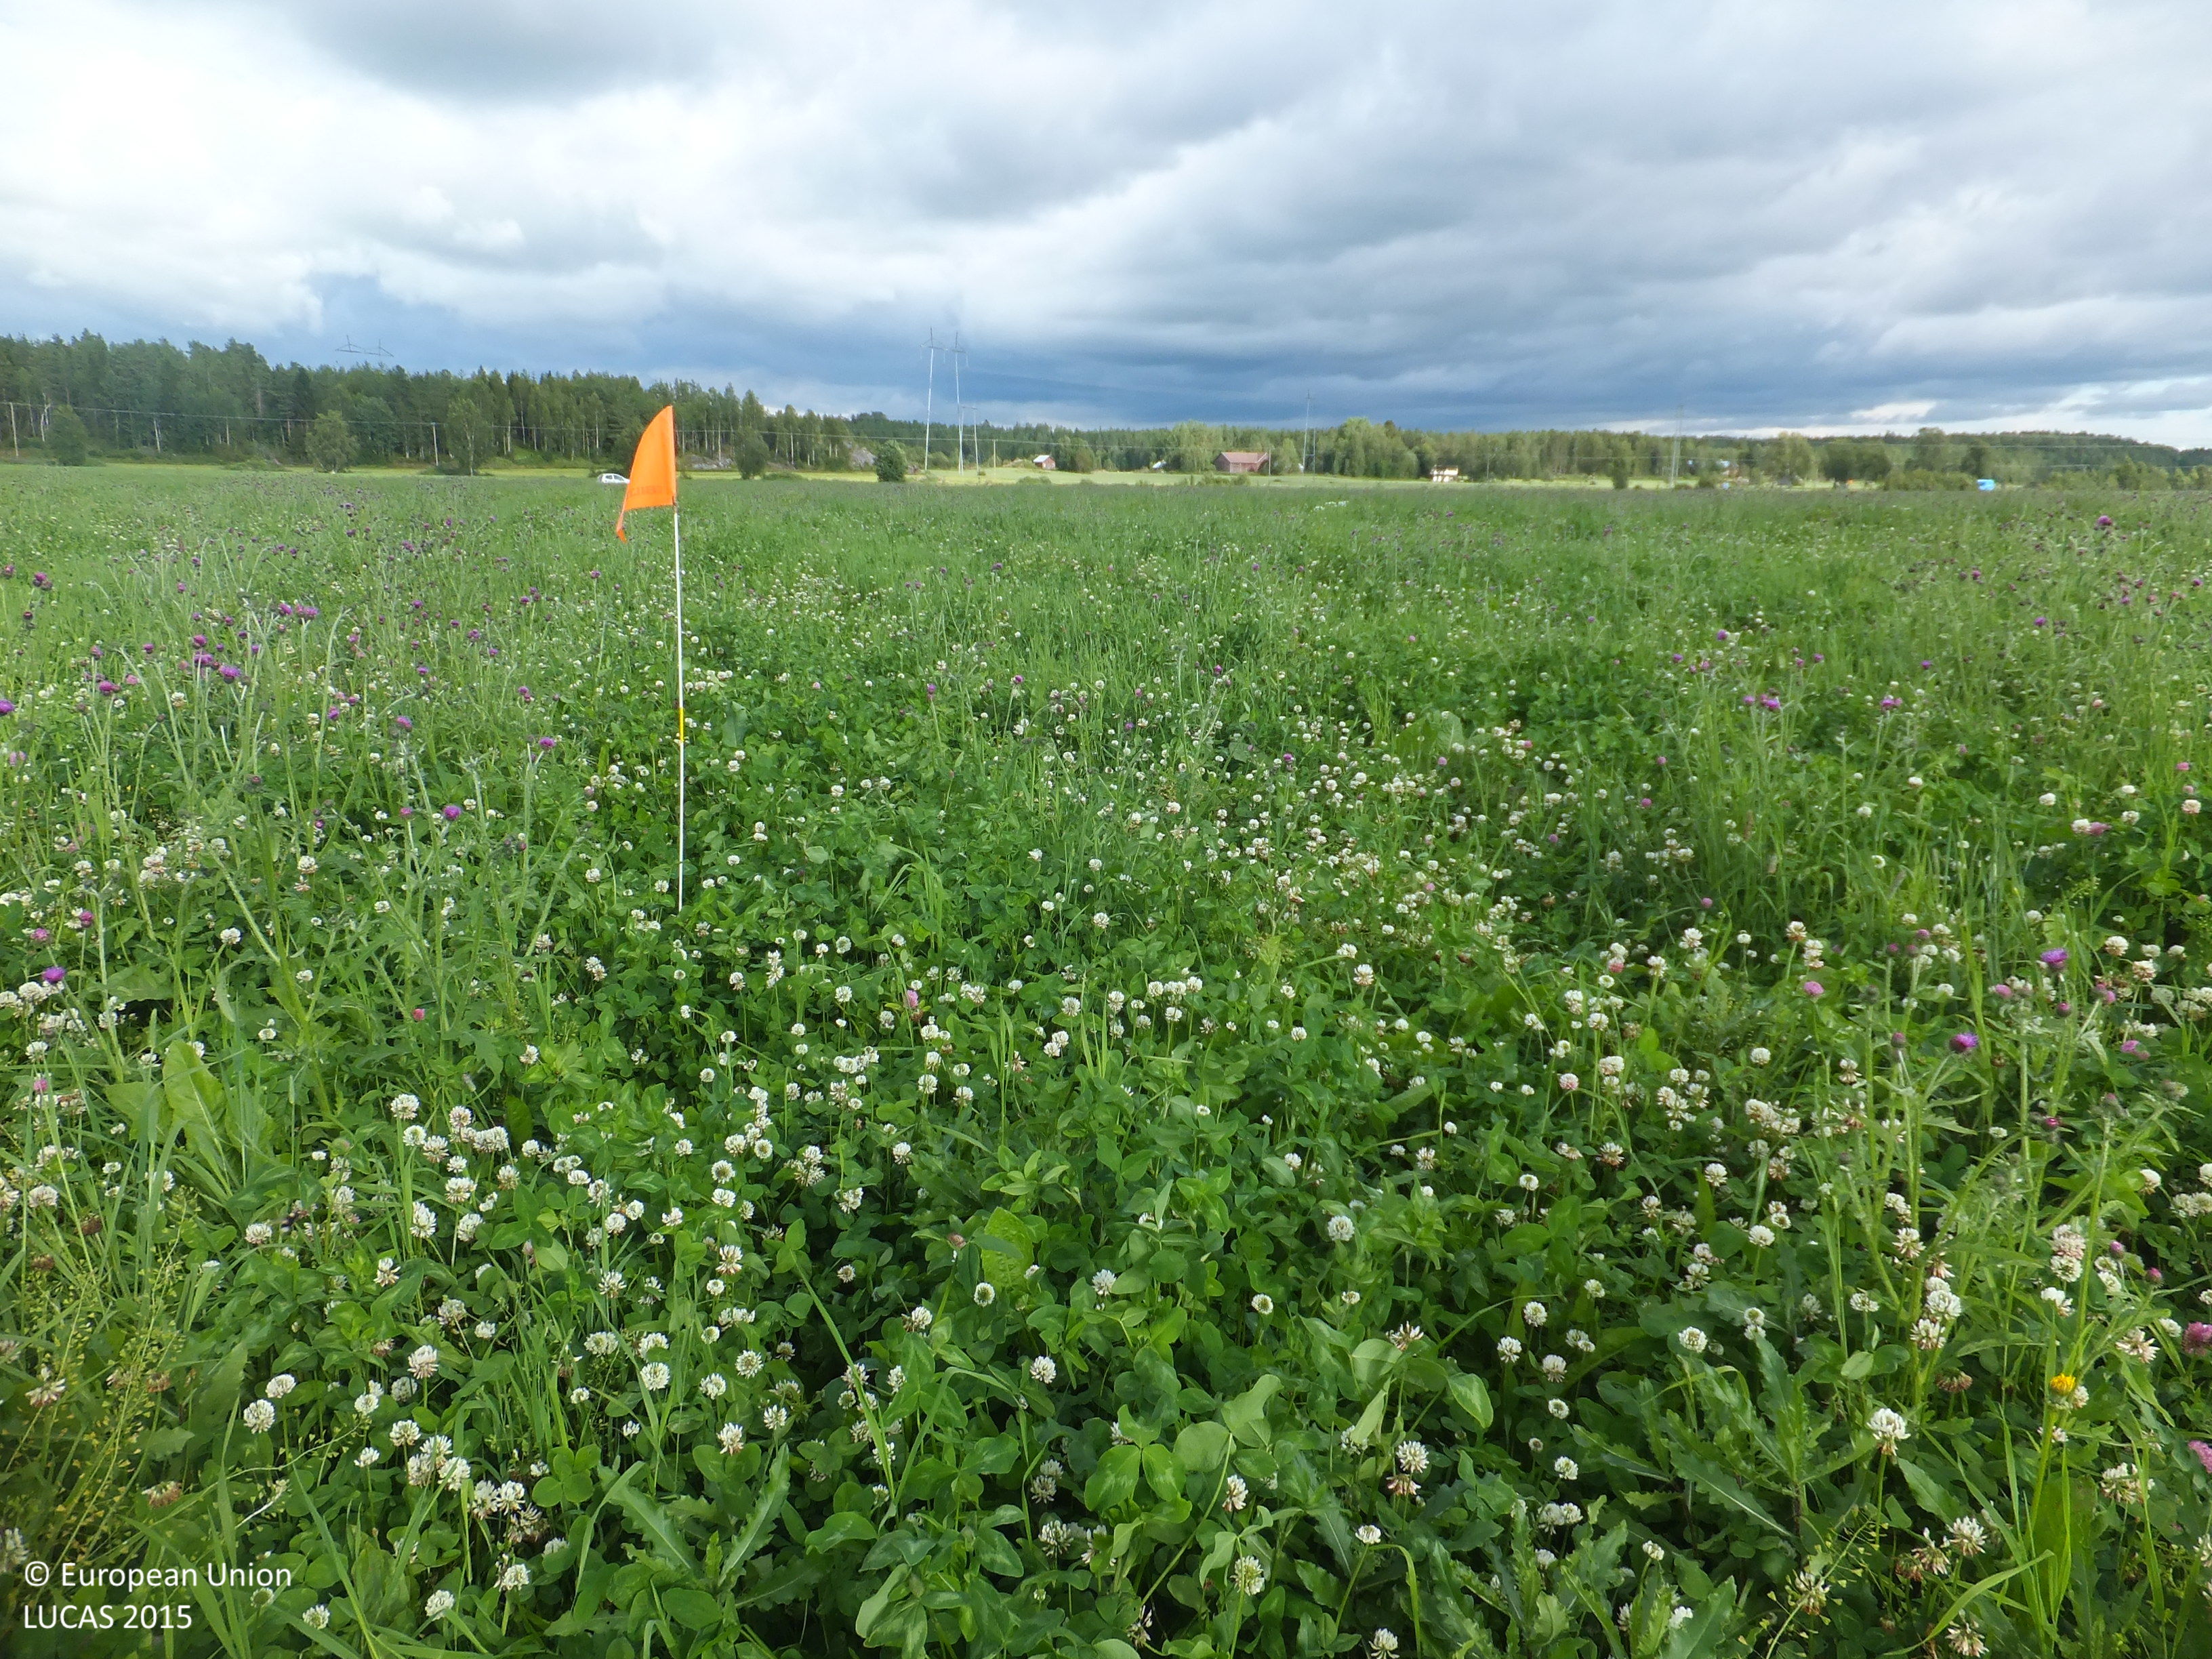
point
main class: Cropland
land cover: Clovers
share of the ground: > 75 %
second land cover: Temporary grasslands
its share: 50 - 75 %
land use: Agriculture (excluding fallow land and kitchen gardens)
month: July
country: FI
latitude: 63.1942
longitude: 22.1900
